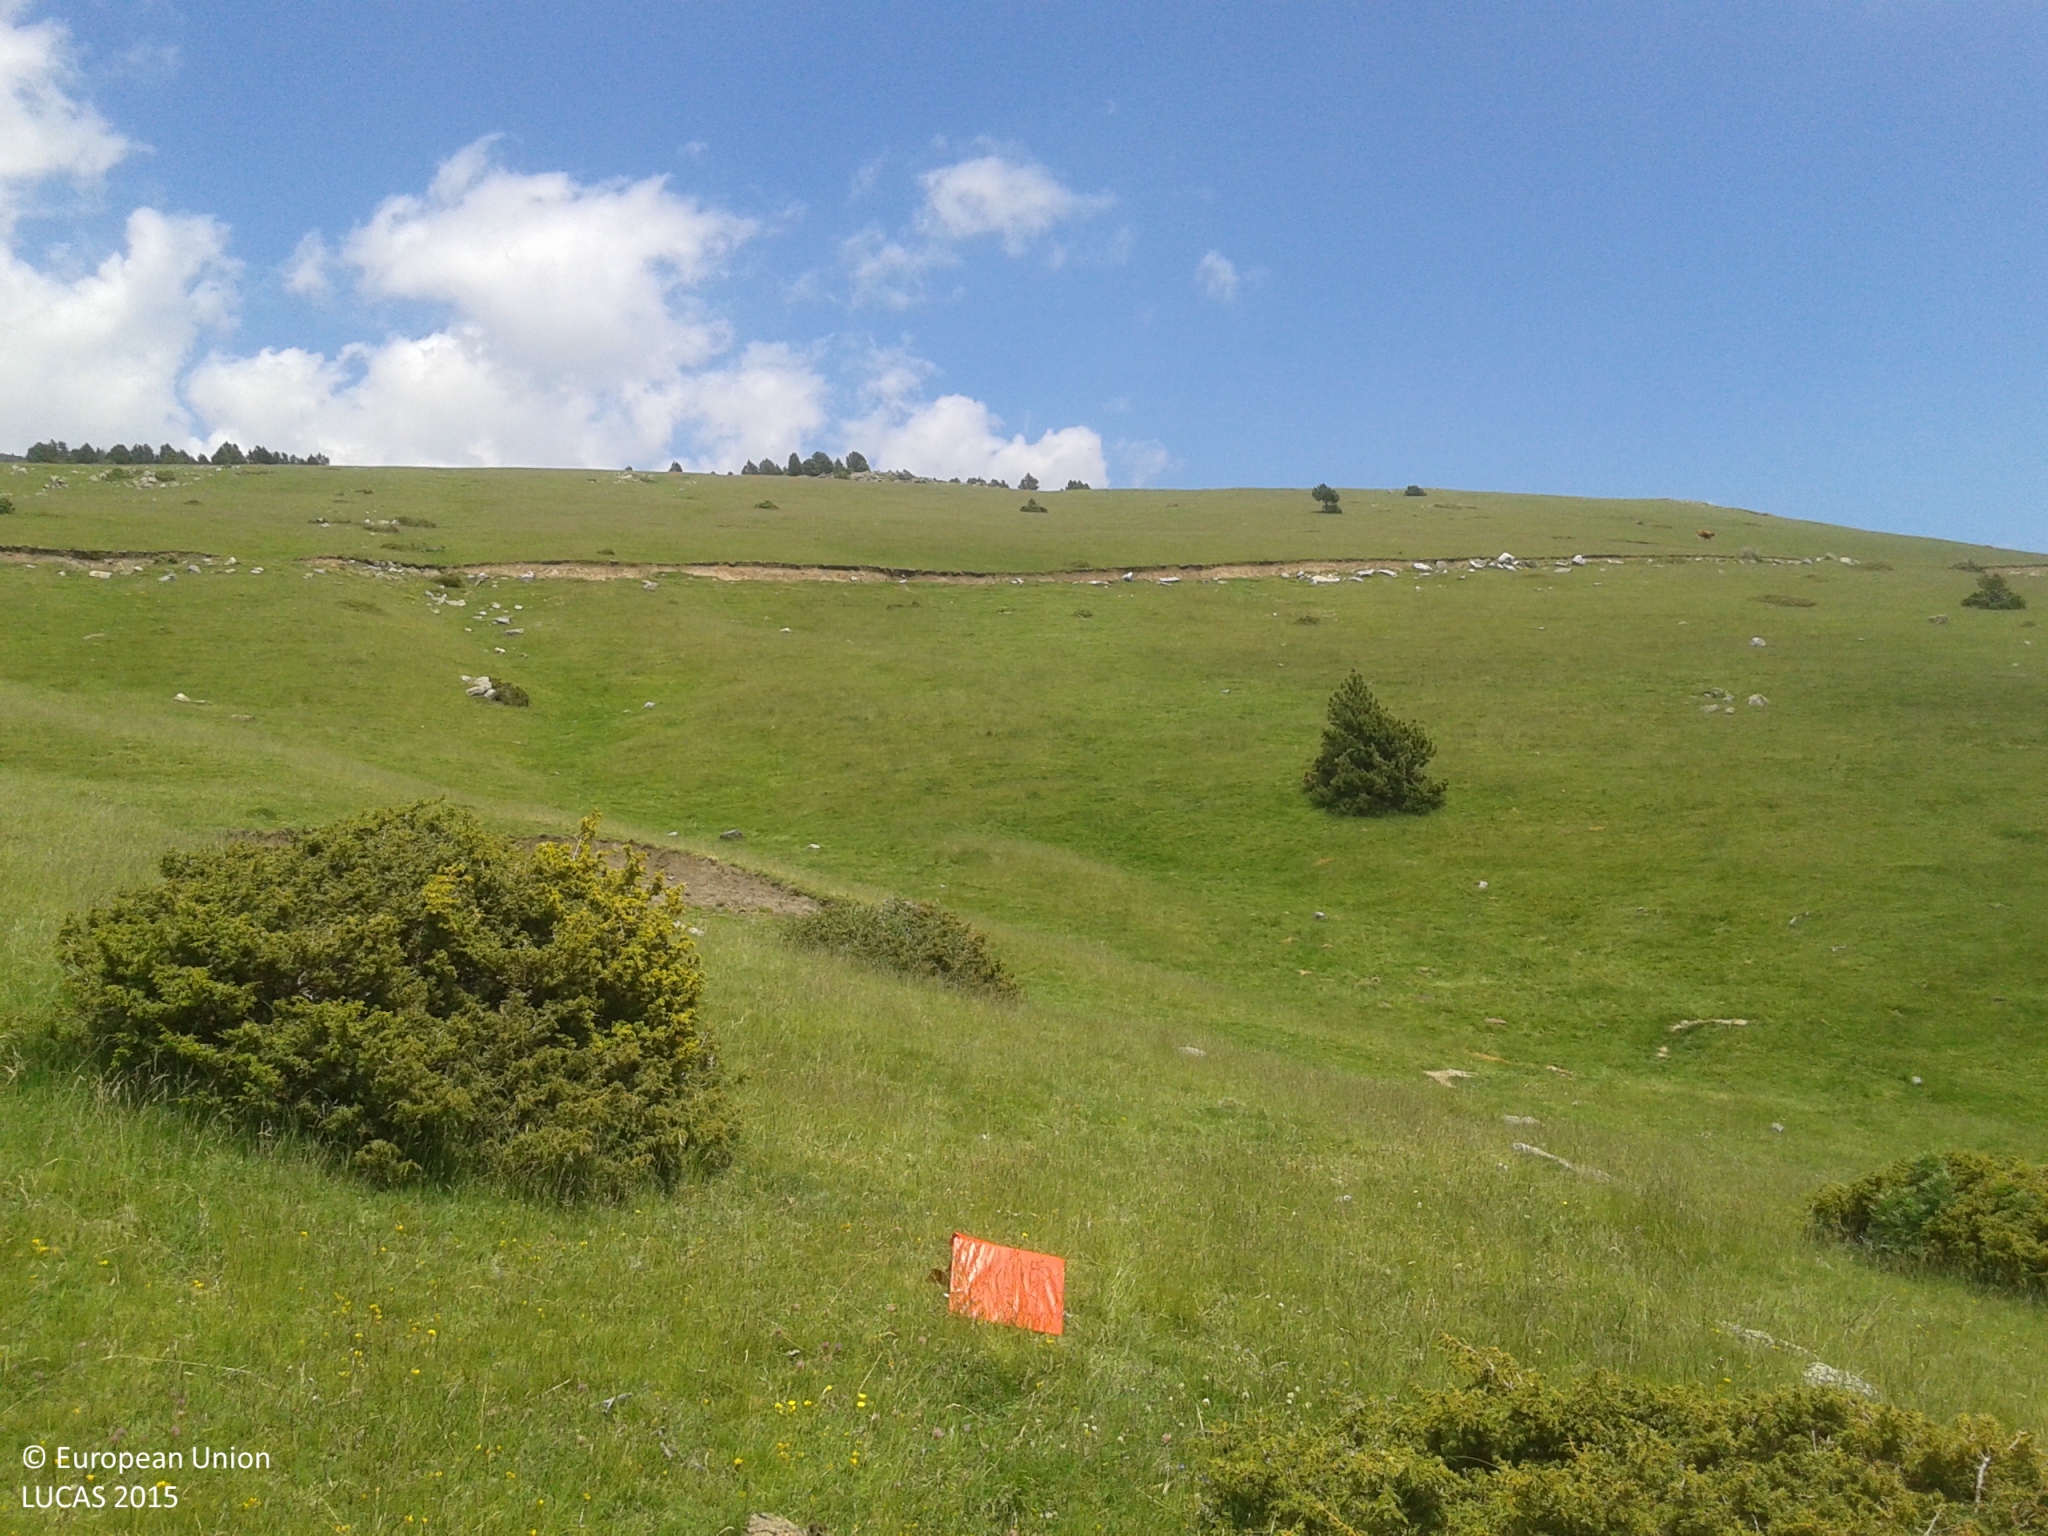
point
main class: Shrubland
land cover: Shrubland with sparse tree cover
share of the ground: > 75 %
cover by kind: herbaceous plants 85 %, shrubs 10 %, coniferous forest trees 5 %
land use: Agriculture (excluding fallow land and kitchen gardens)
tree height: > 5 m
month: June
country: ES
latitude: 42.4126
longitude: 1.5891
